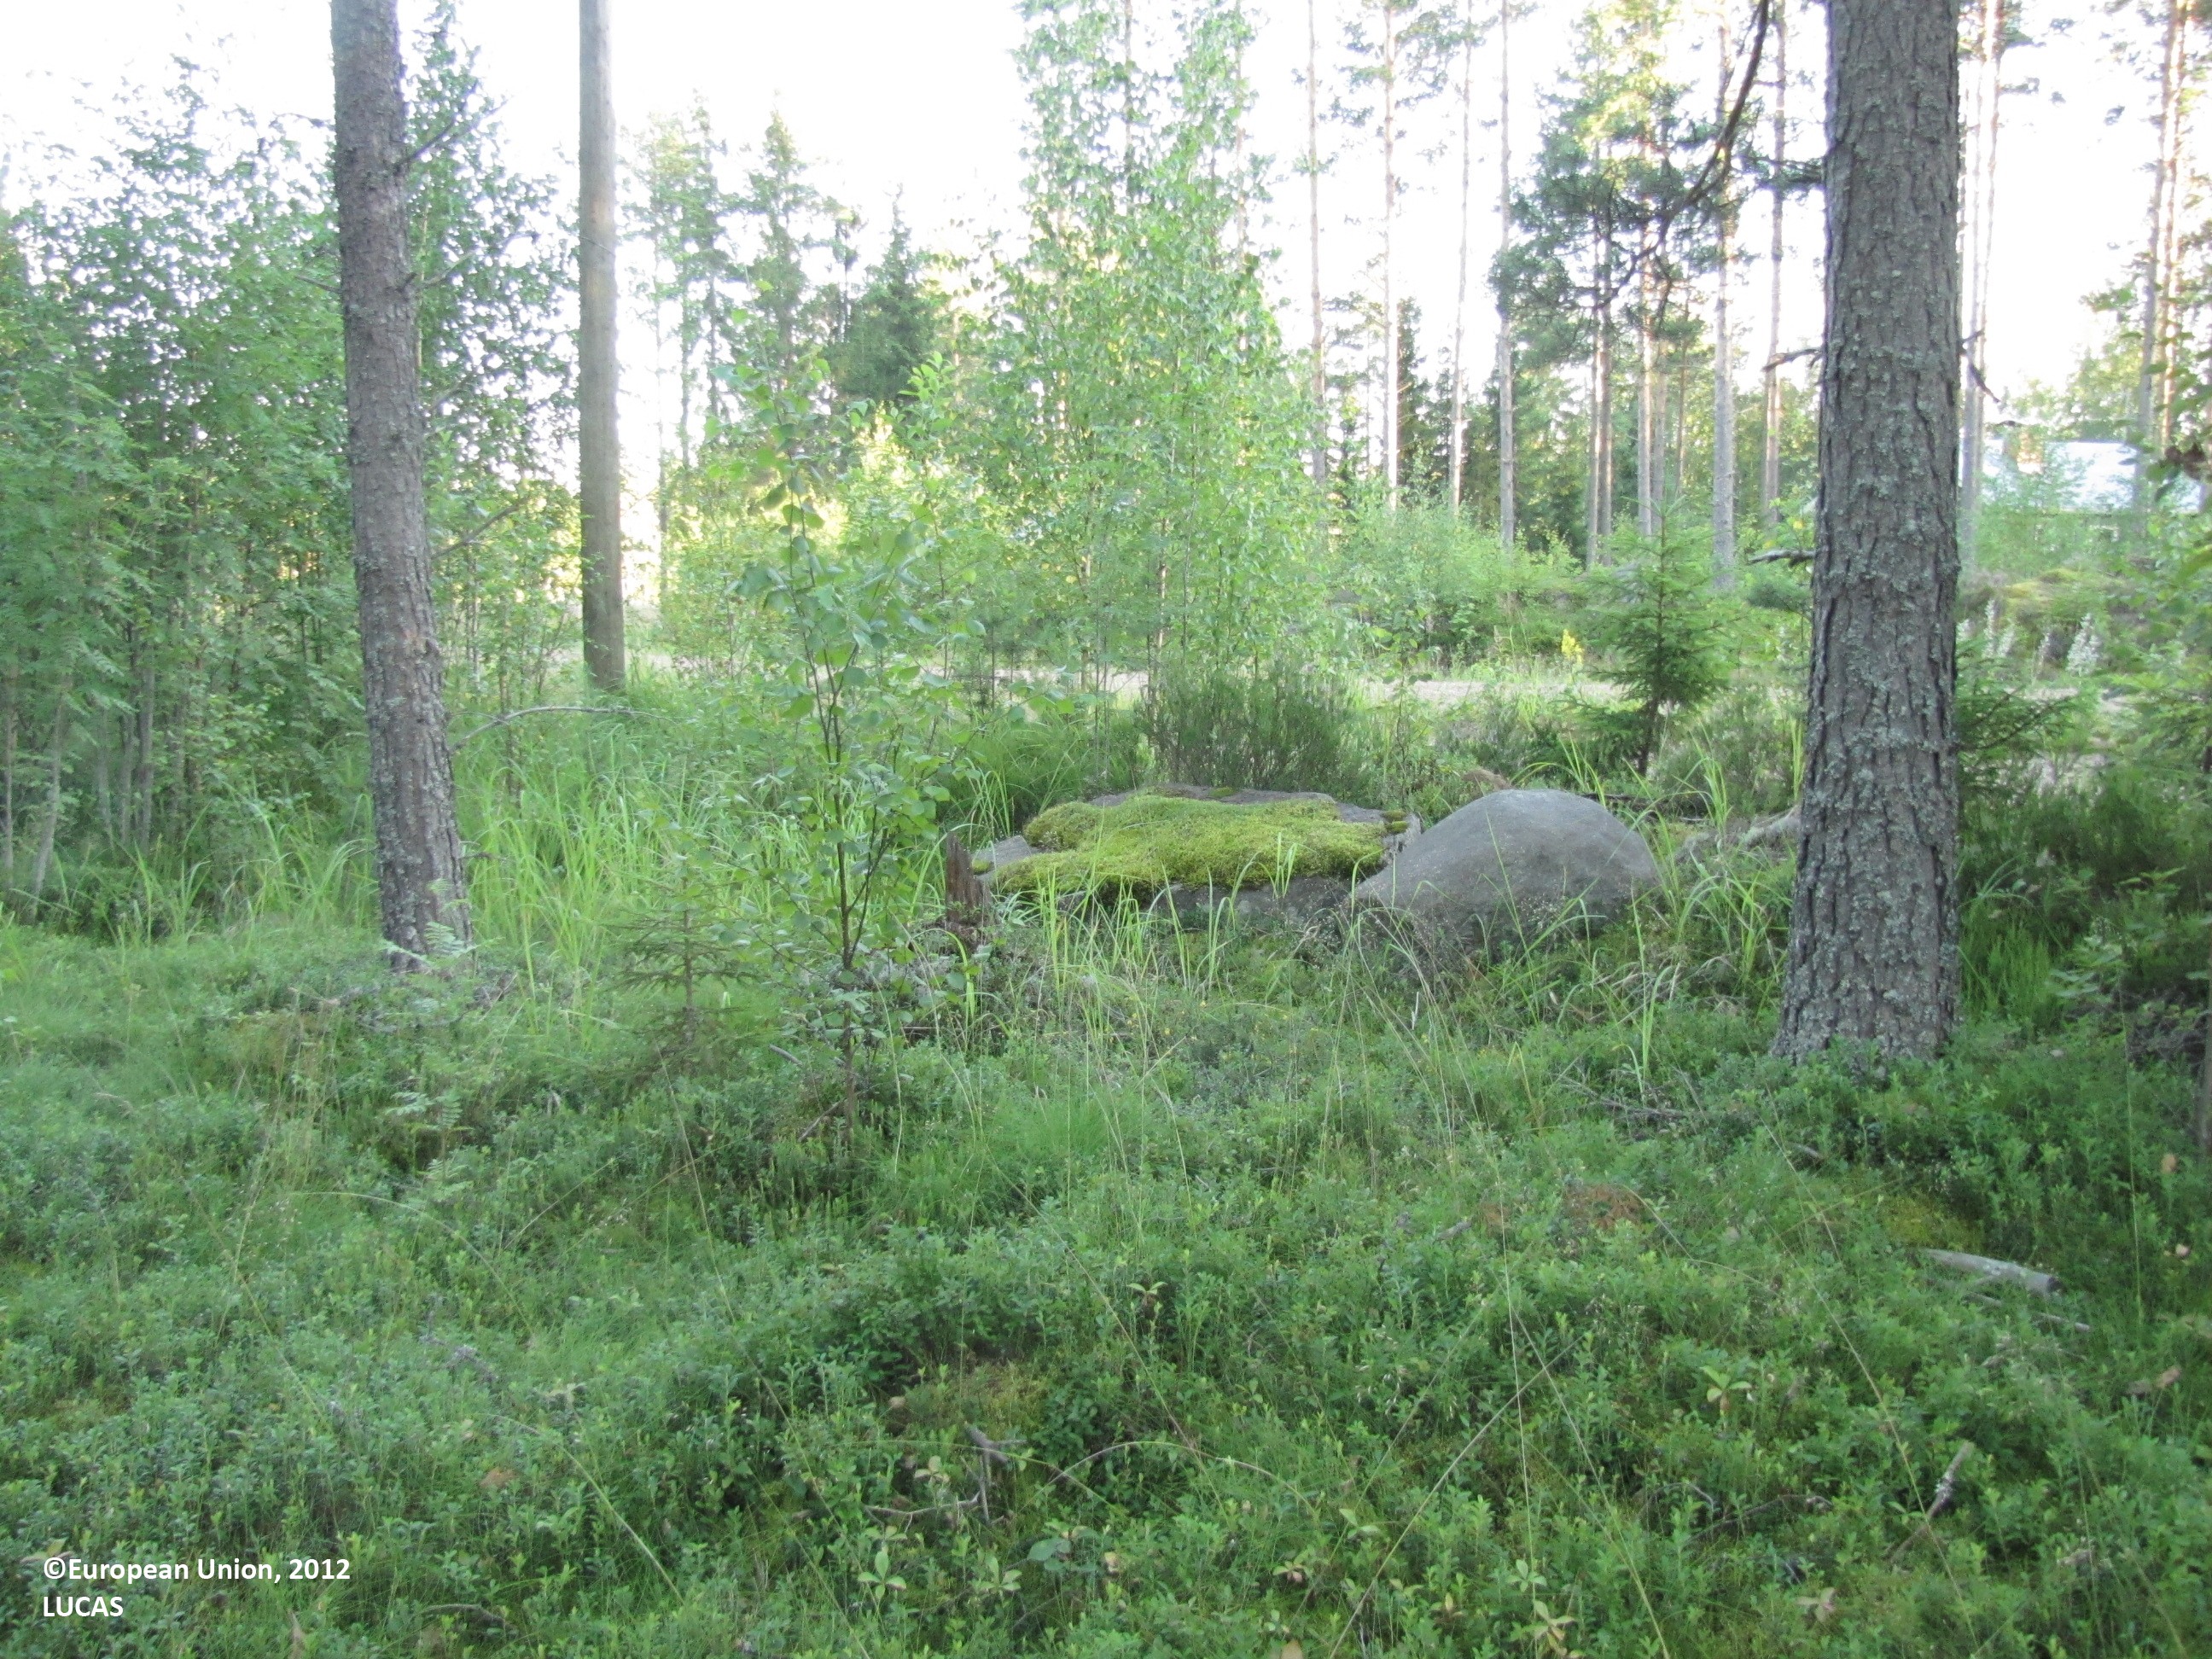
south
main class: Woodland
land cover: Pine dominated coniferous woodland
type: boreal forest
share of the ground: 50 - 75 %
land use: Forestry
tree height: > 5 m
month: July
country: FI
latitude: 62.0800
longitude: 23.0274
